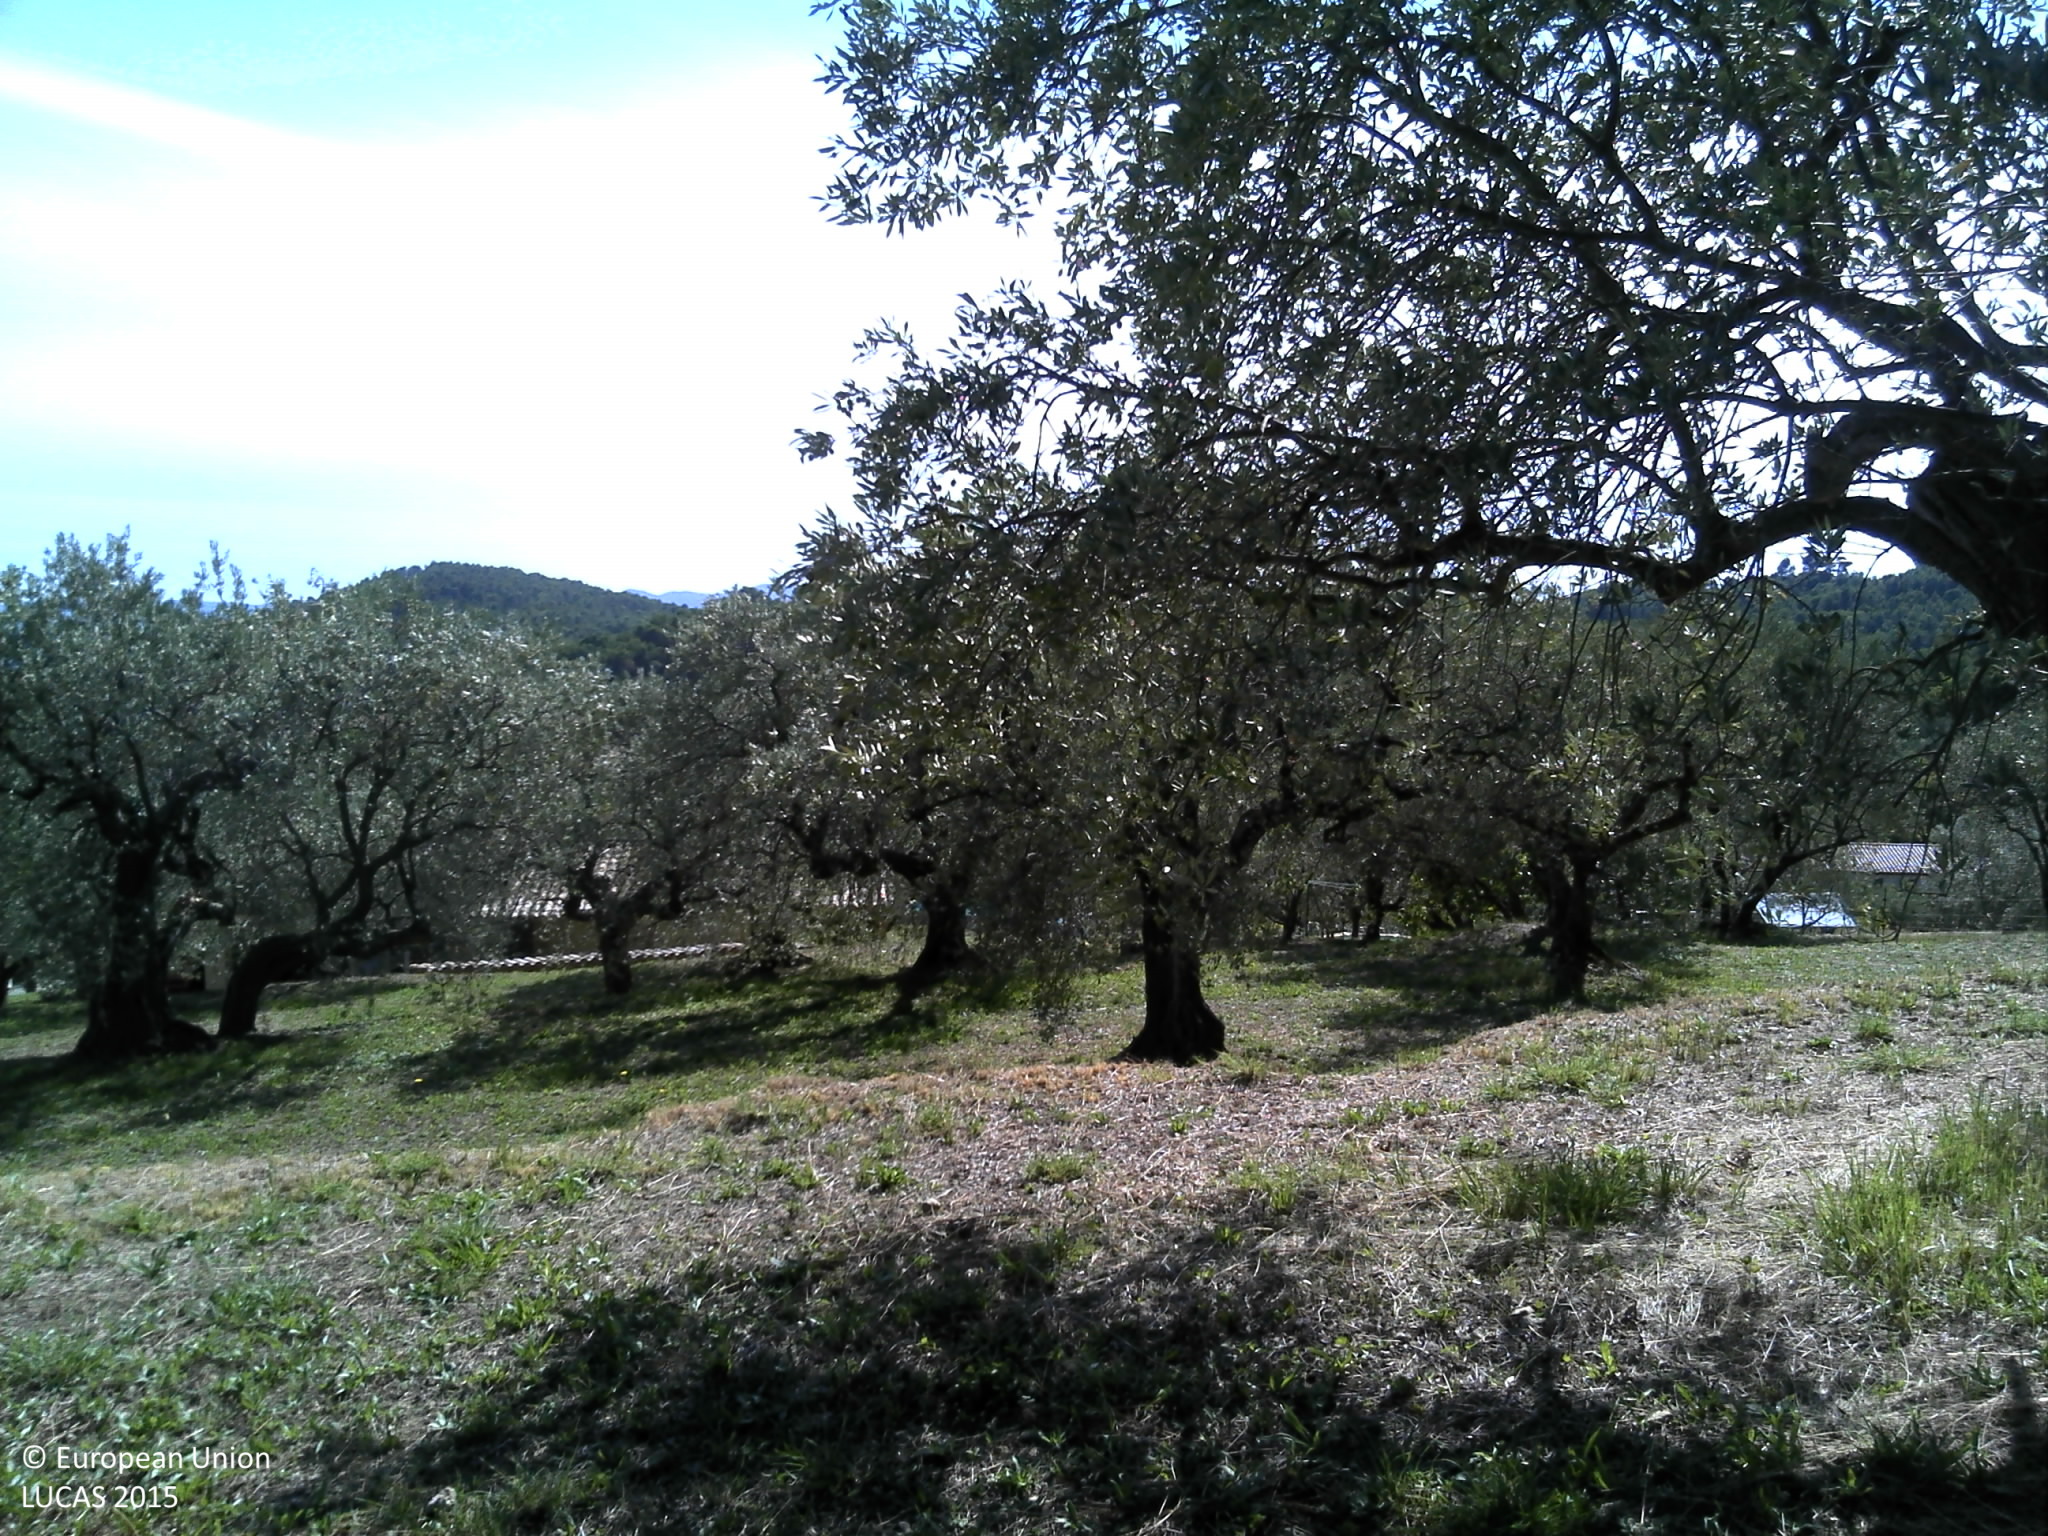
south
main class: Cropland
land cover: Olive groves
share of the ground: 25 - 50 %
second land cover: Grassland without tree/shrub cover
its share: 50 - 75 %
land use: Agriculture (excluding fallow land and kitchen gardens)
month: September
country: FR
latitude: 43.6276
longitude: 6.6245
